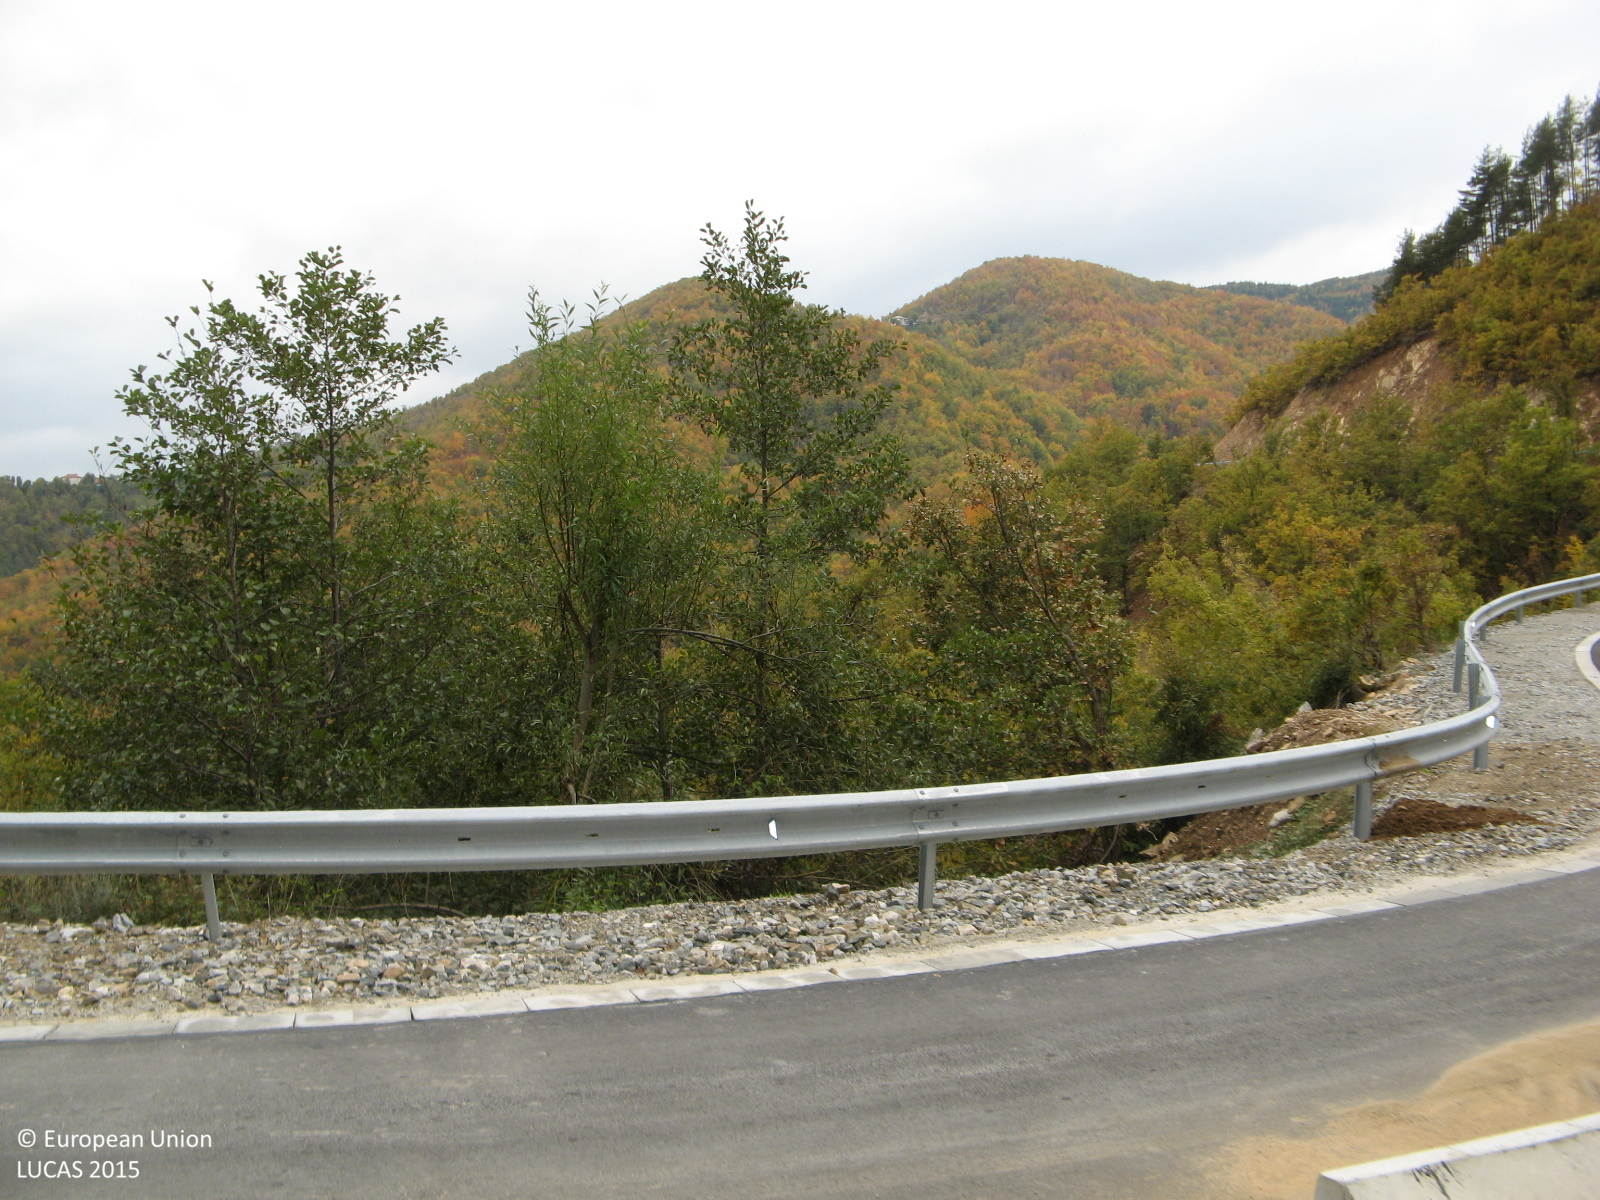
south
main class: Shrubland
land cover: Shrubland with sparse tree cover
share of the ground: > 75 %
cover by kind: shrubs 90 %, broadleaved forest trees 5 %, herbaceous plants 5 %
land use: Semi-natural and natural areas not in use
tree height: < 5 m
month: October
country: BG
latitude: 41.4704
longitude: 25.0277
